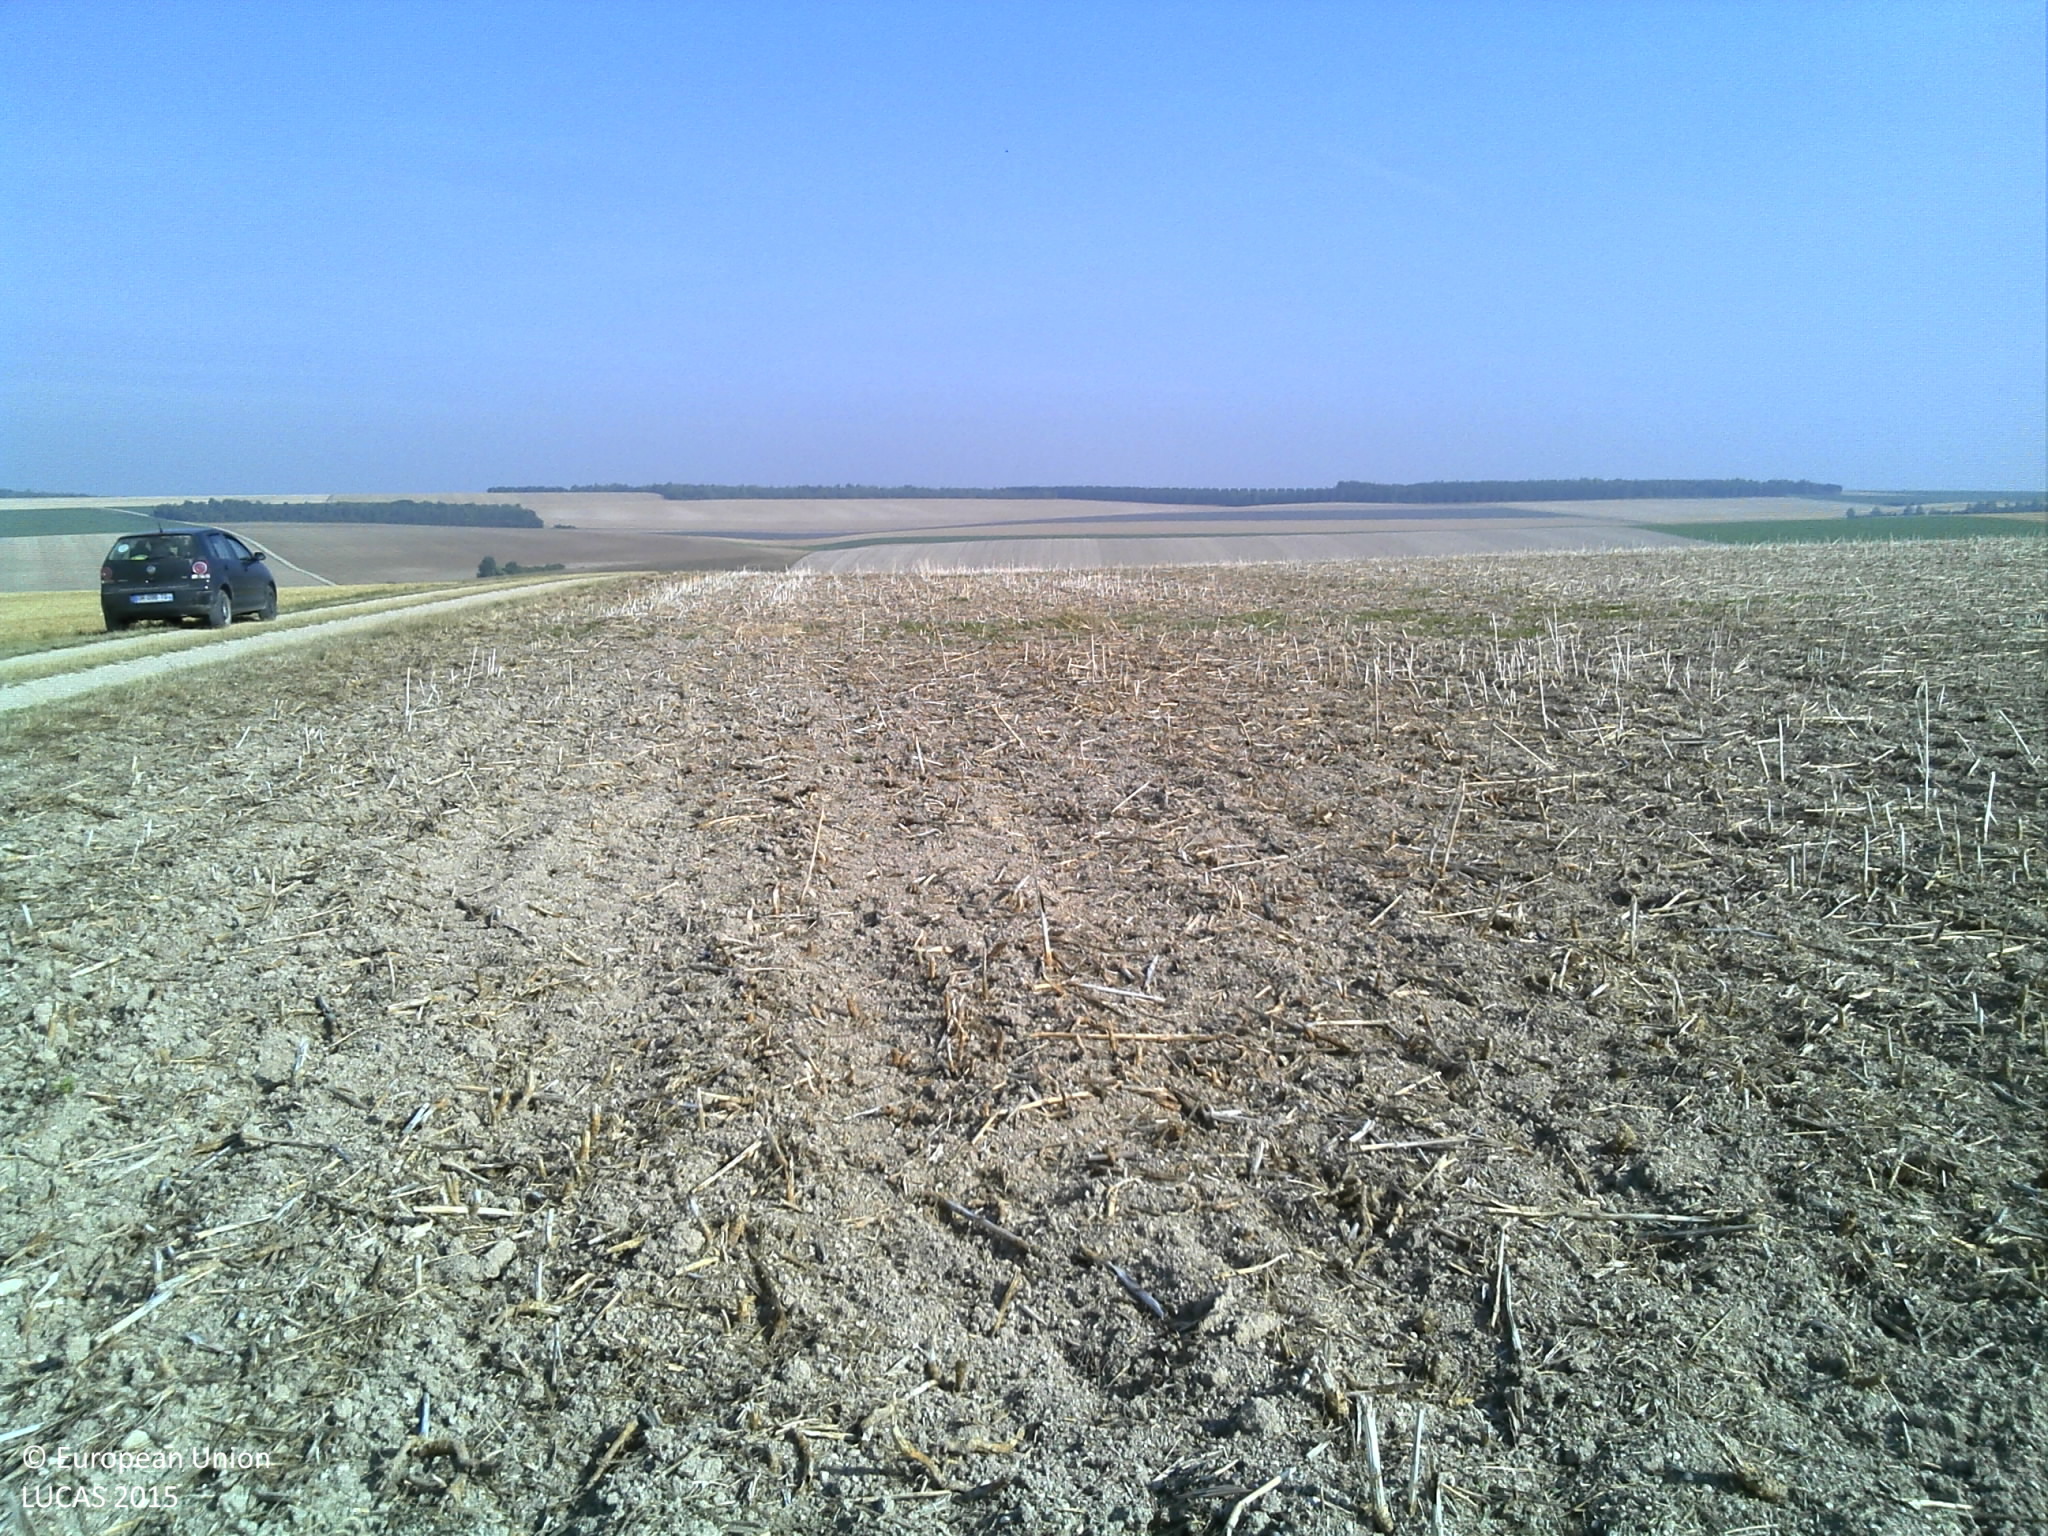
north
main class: Cropland
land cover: Rape and turnip rape
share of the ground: > 75 %
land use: Agriculture (excluding fallow land and kitchen gardens)
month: August
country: FR
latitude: 48.9376
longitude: 4.5772
